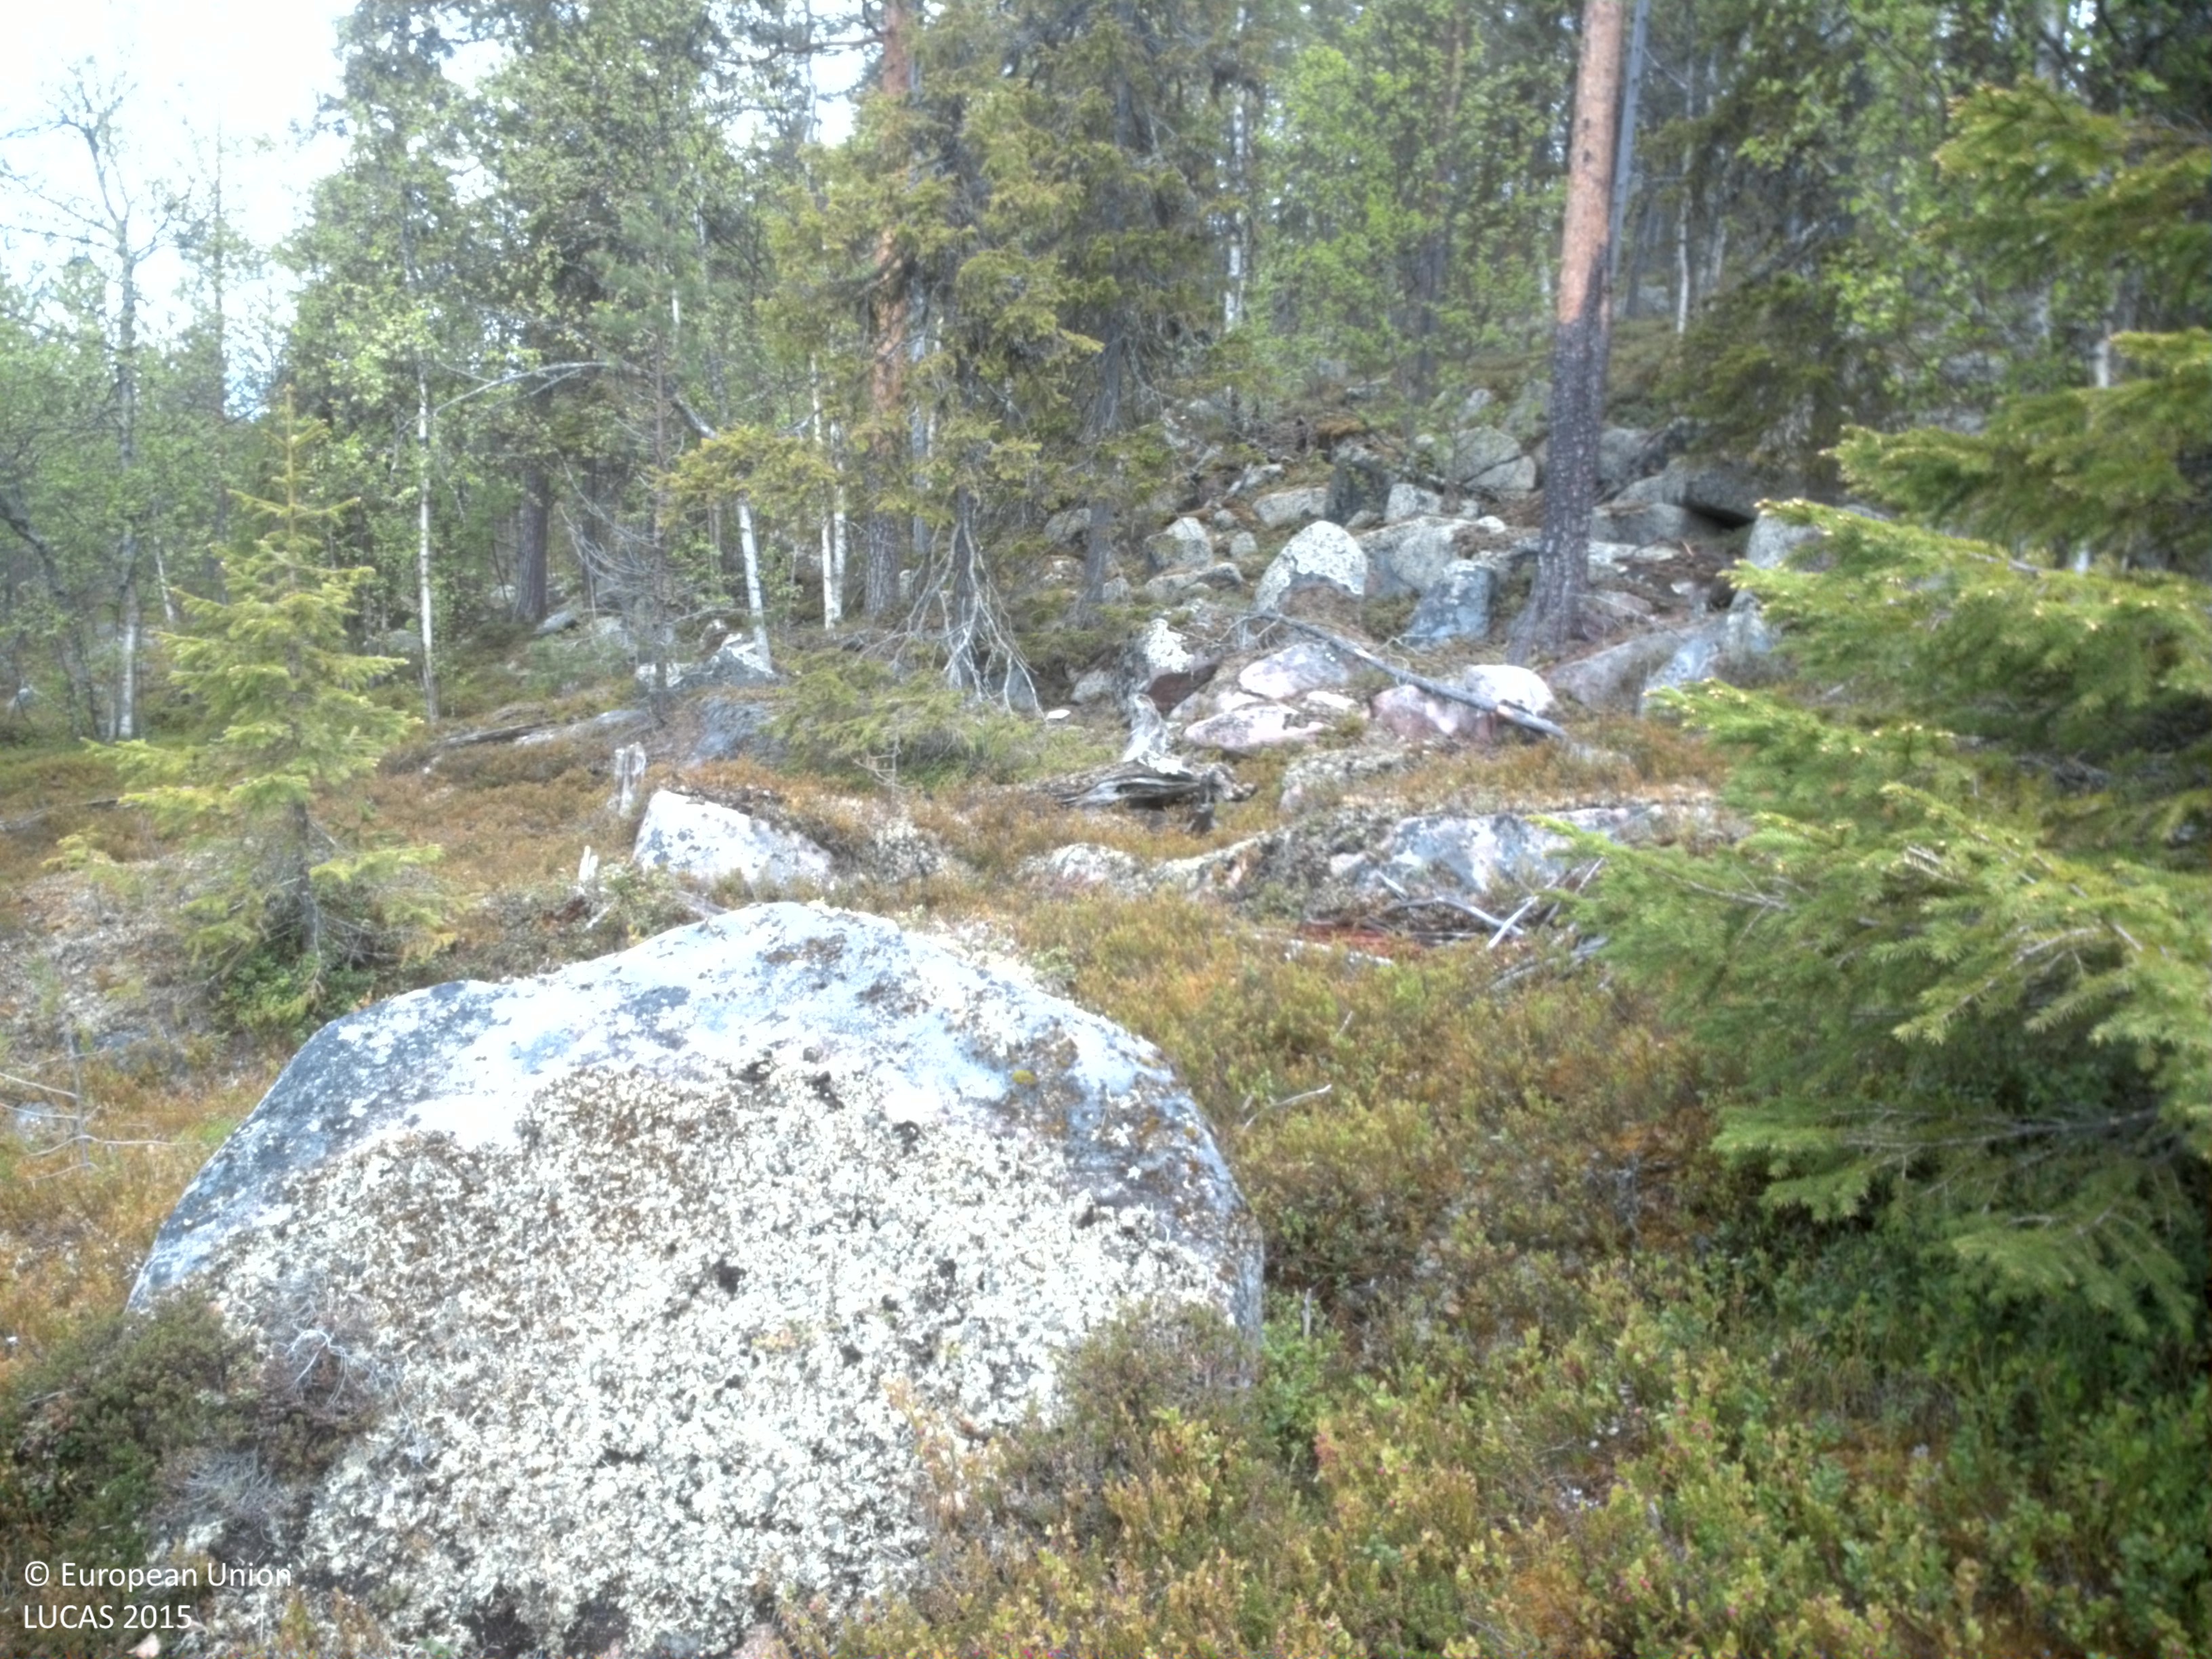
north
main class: Woodland
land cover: Spruce dominated coniferous woodland
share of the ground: 10 - 25 %
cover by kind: herbaceous plants 75 %, coniferous forest trees 10 %, lichens and mosses 10 %, shrubs 5 %
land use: Forestry
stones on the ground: < 10 %
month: June
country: SE
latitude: 66.7877
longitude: 22.4496
